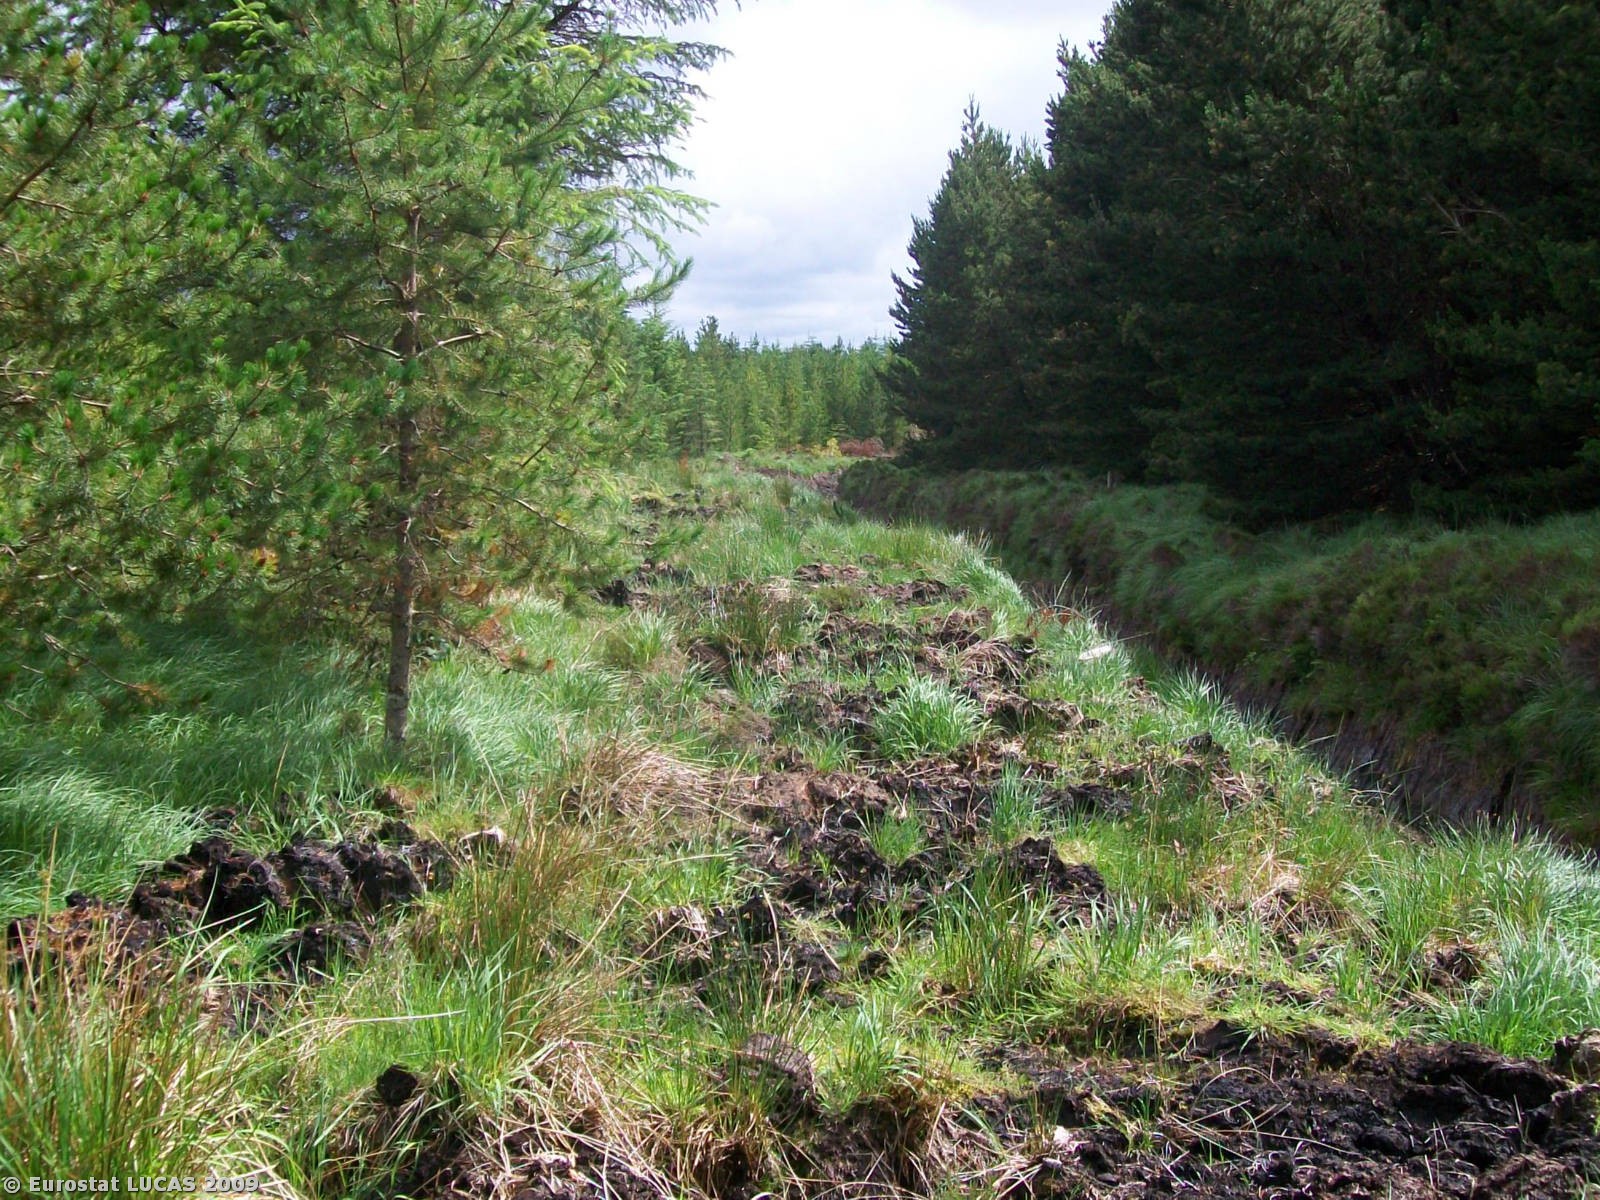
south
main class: Woodland
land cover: Coniferous woodland
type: plantations and self-sown exotic forest
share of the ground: > 75 %
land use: Forestry
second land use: Nature reserves
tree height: > 5 m
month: July
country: IE
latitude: 54.0814
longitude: -9.7942
